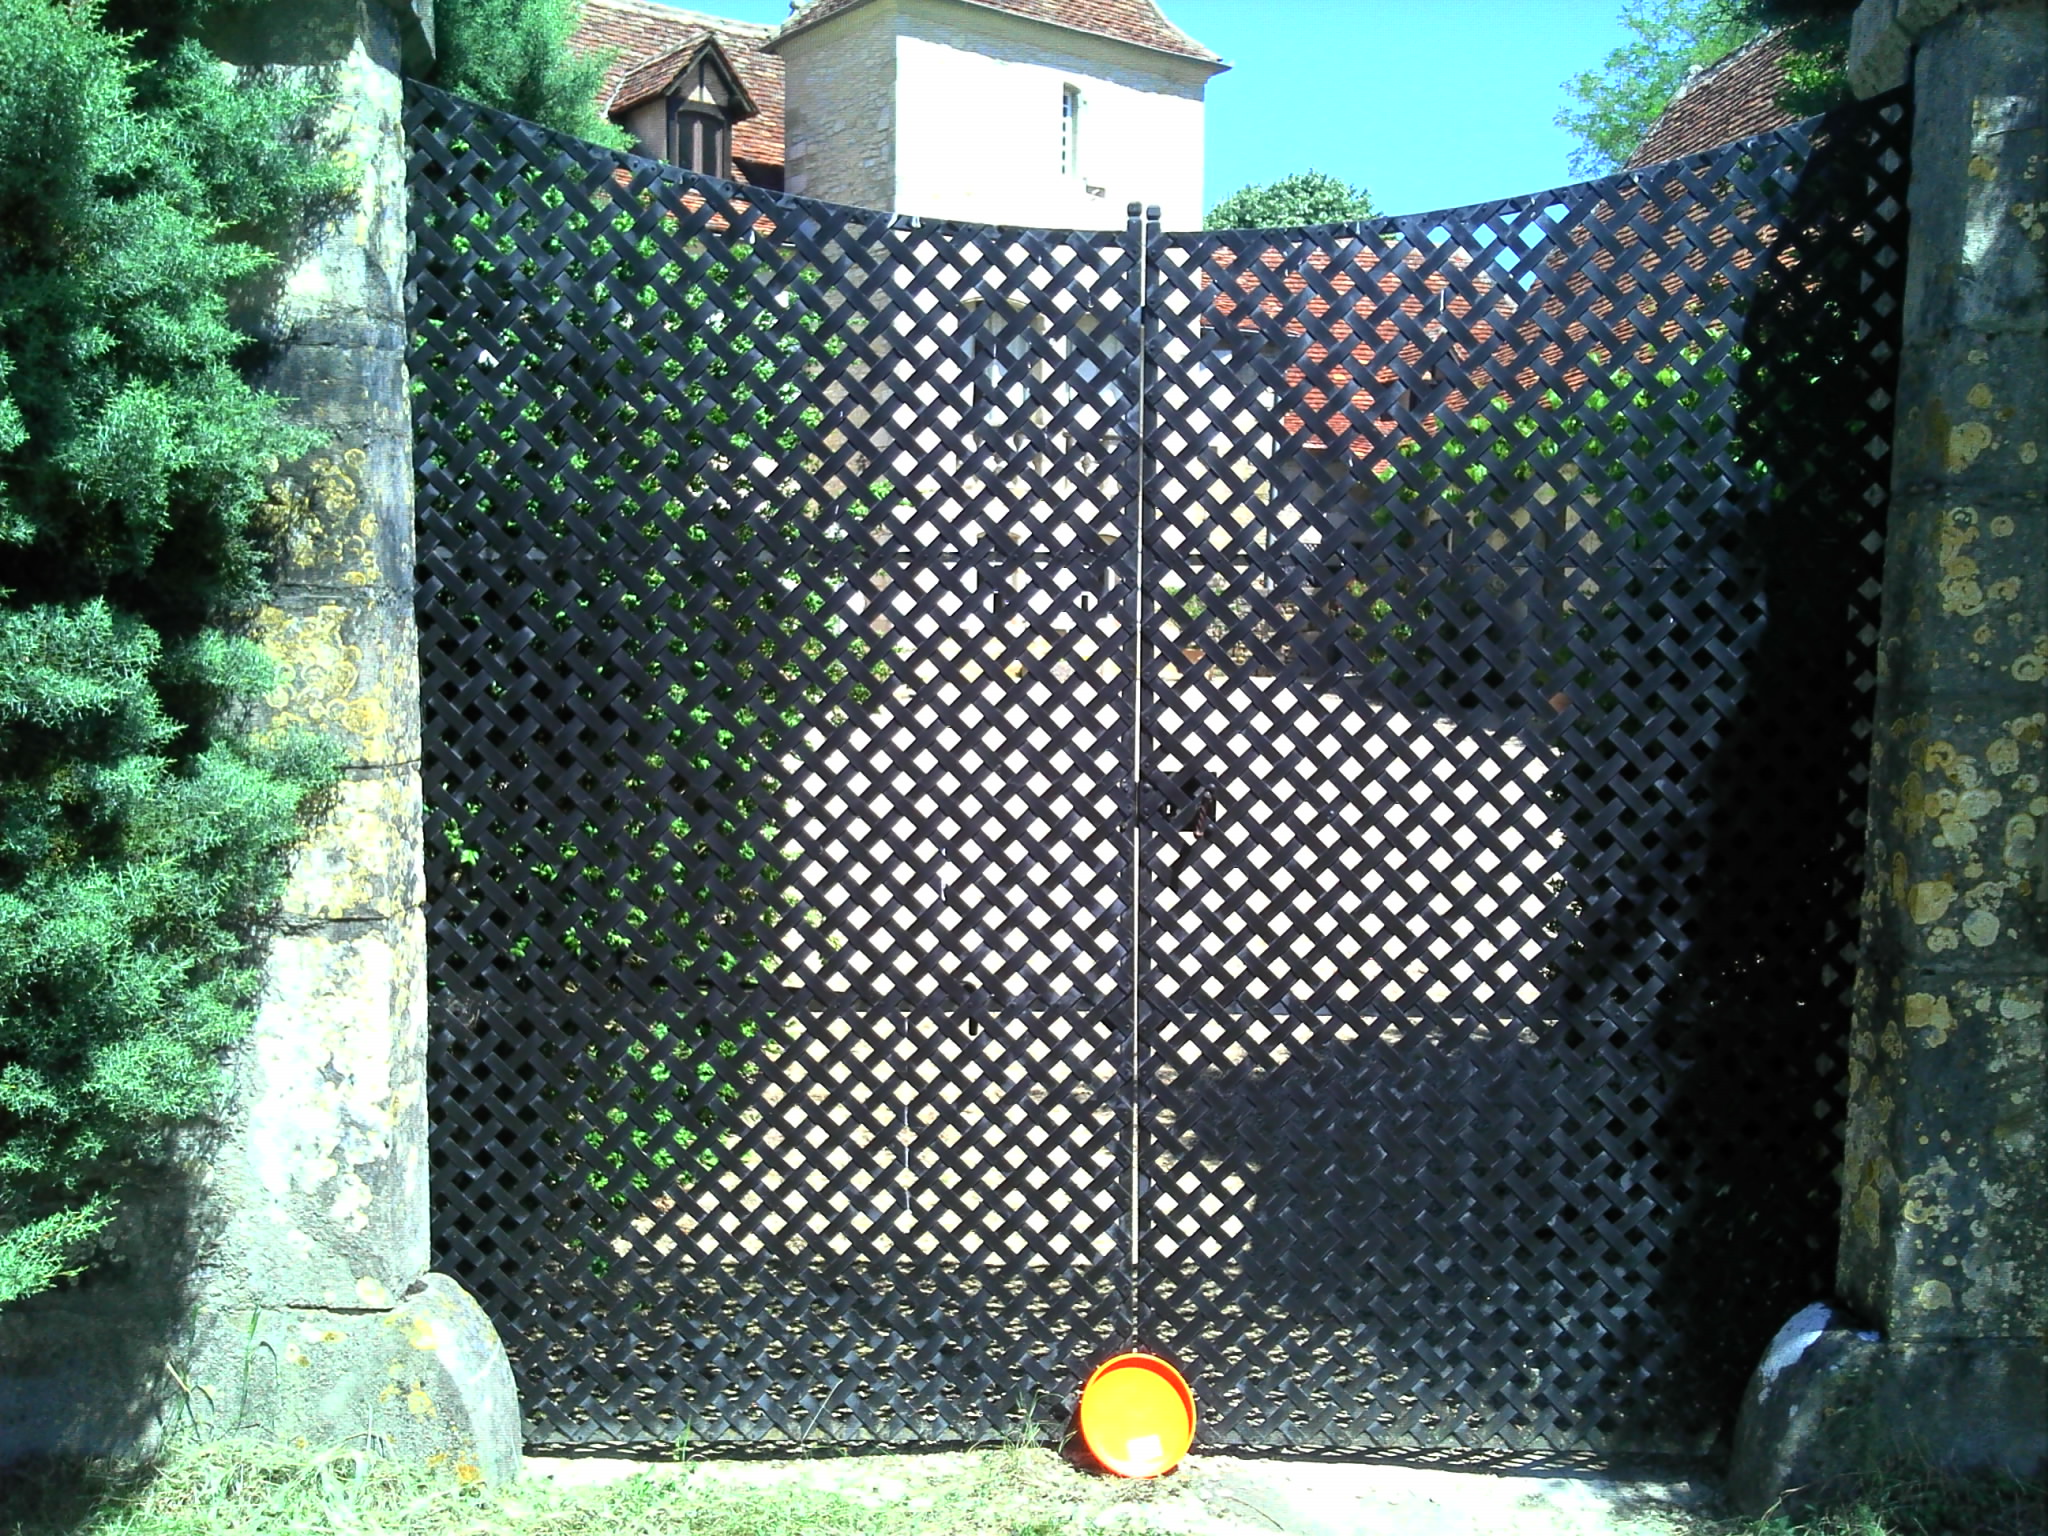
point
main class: Woodland
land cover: Broadleaved woodland
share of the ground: > 75 %
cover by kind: broadleaved forest trees 50 %, herbaceous plants 50 %
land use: Residential
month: May
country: FR
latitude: 44.6290
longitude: 1.8693
